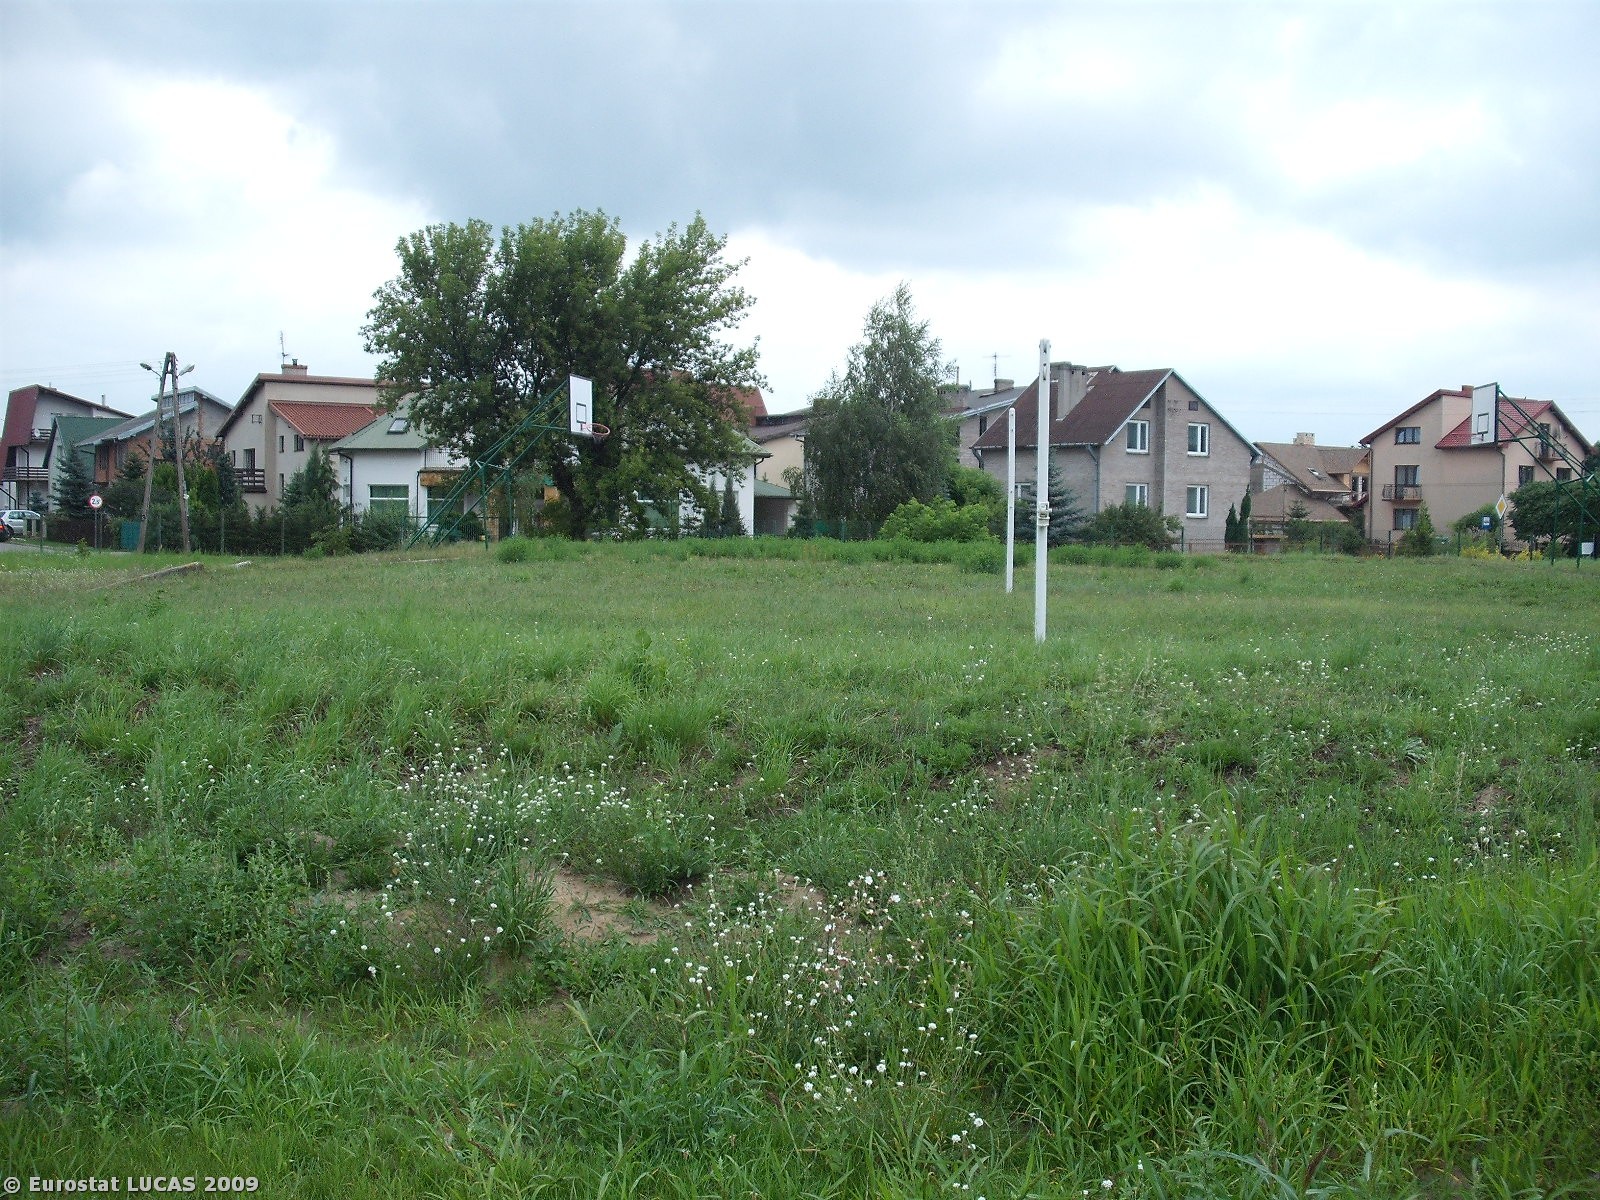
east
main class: Grassland
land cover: Grassland without tree/shrub cover
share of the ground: 25 - 50 %
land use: Community services
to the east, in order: Grassland without tree/shrub cover; Artificial constructions in urban areas
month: July
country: PL
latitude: 50.9577
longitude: 21.3674
